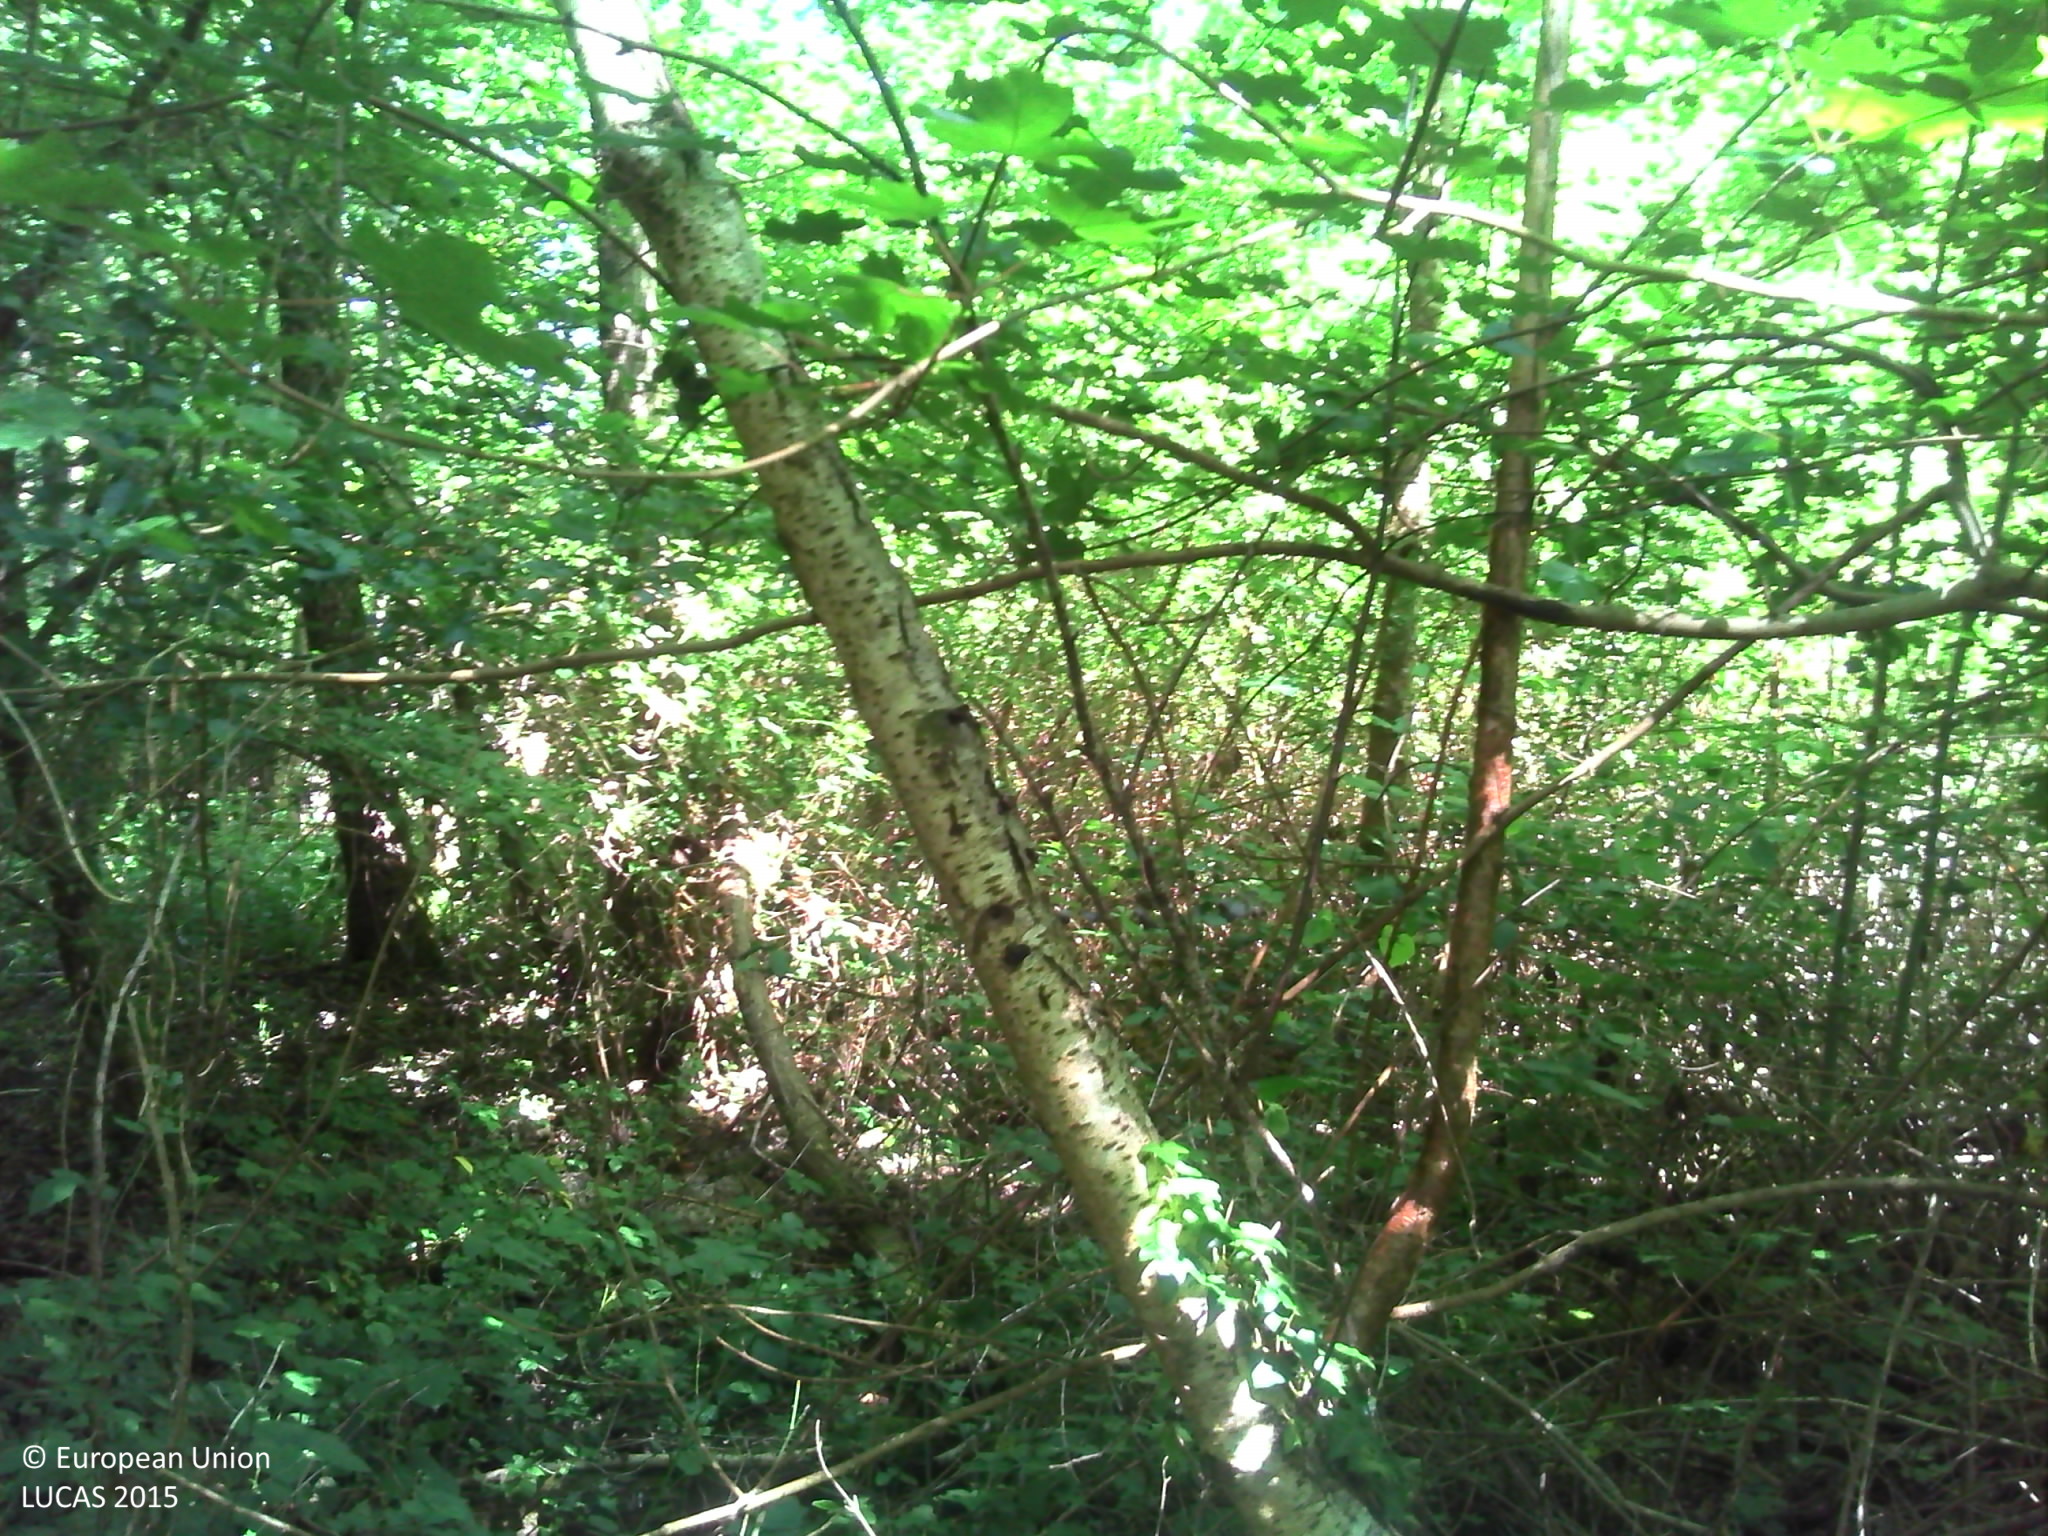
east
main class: Woodland
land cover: Broadleaved woodland
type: acidophilous oak and oak-birch forest
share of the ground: > 75 %
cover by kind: broadleaved forest trees 100 %
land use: Forestry
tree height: > 5 m
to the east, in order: Broadleaved woodland; Rivers and streams; Broadleaved woodland; Tracks; Spontaneously vegetated surfaces; Grass margins; Paved roads, cycling and walking lanes; Grass margins
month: June
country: FR
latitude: 47.5744
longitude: 2.5607
